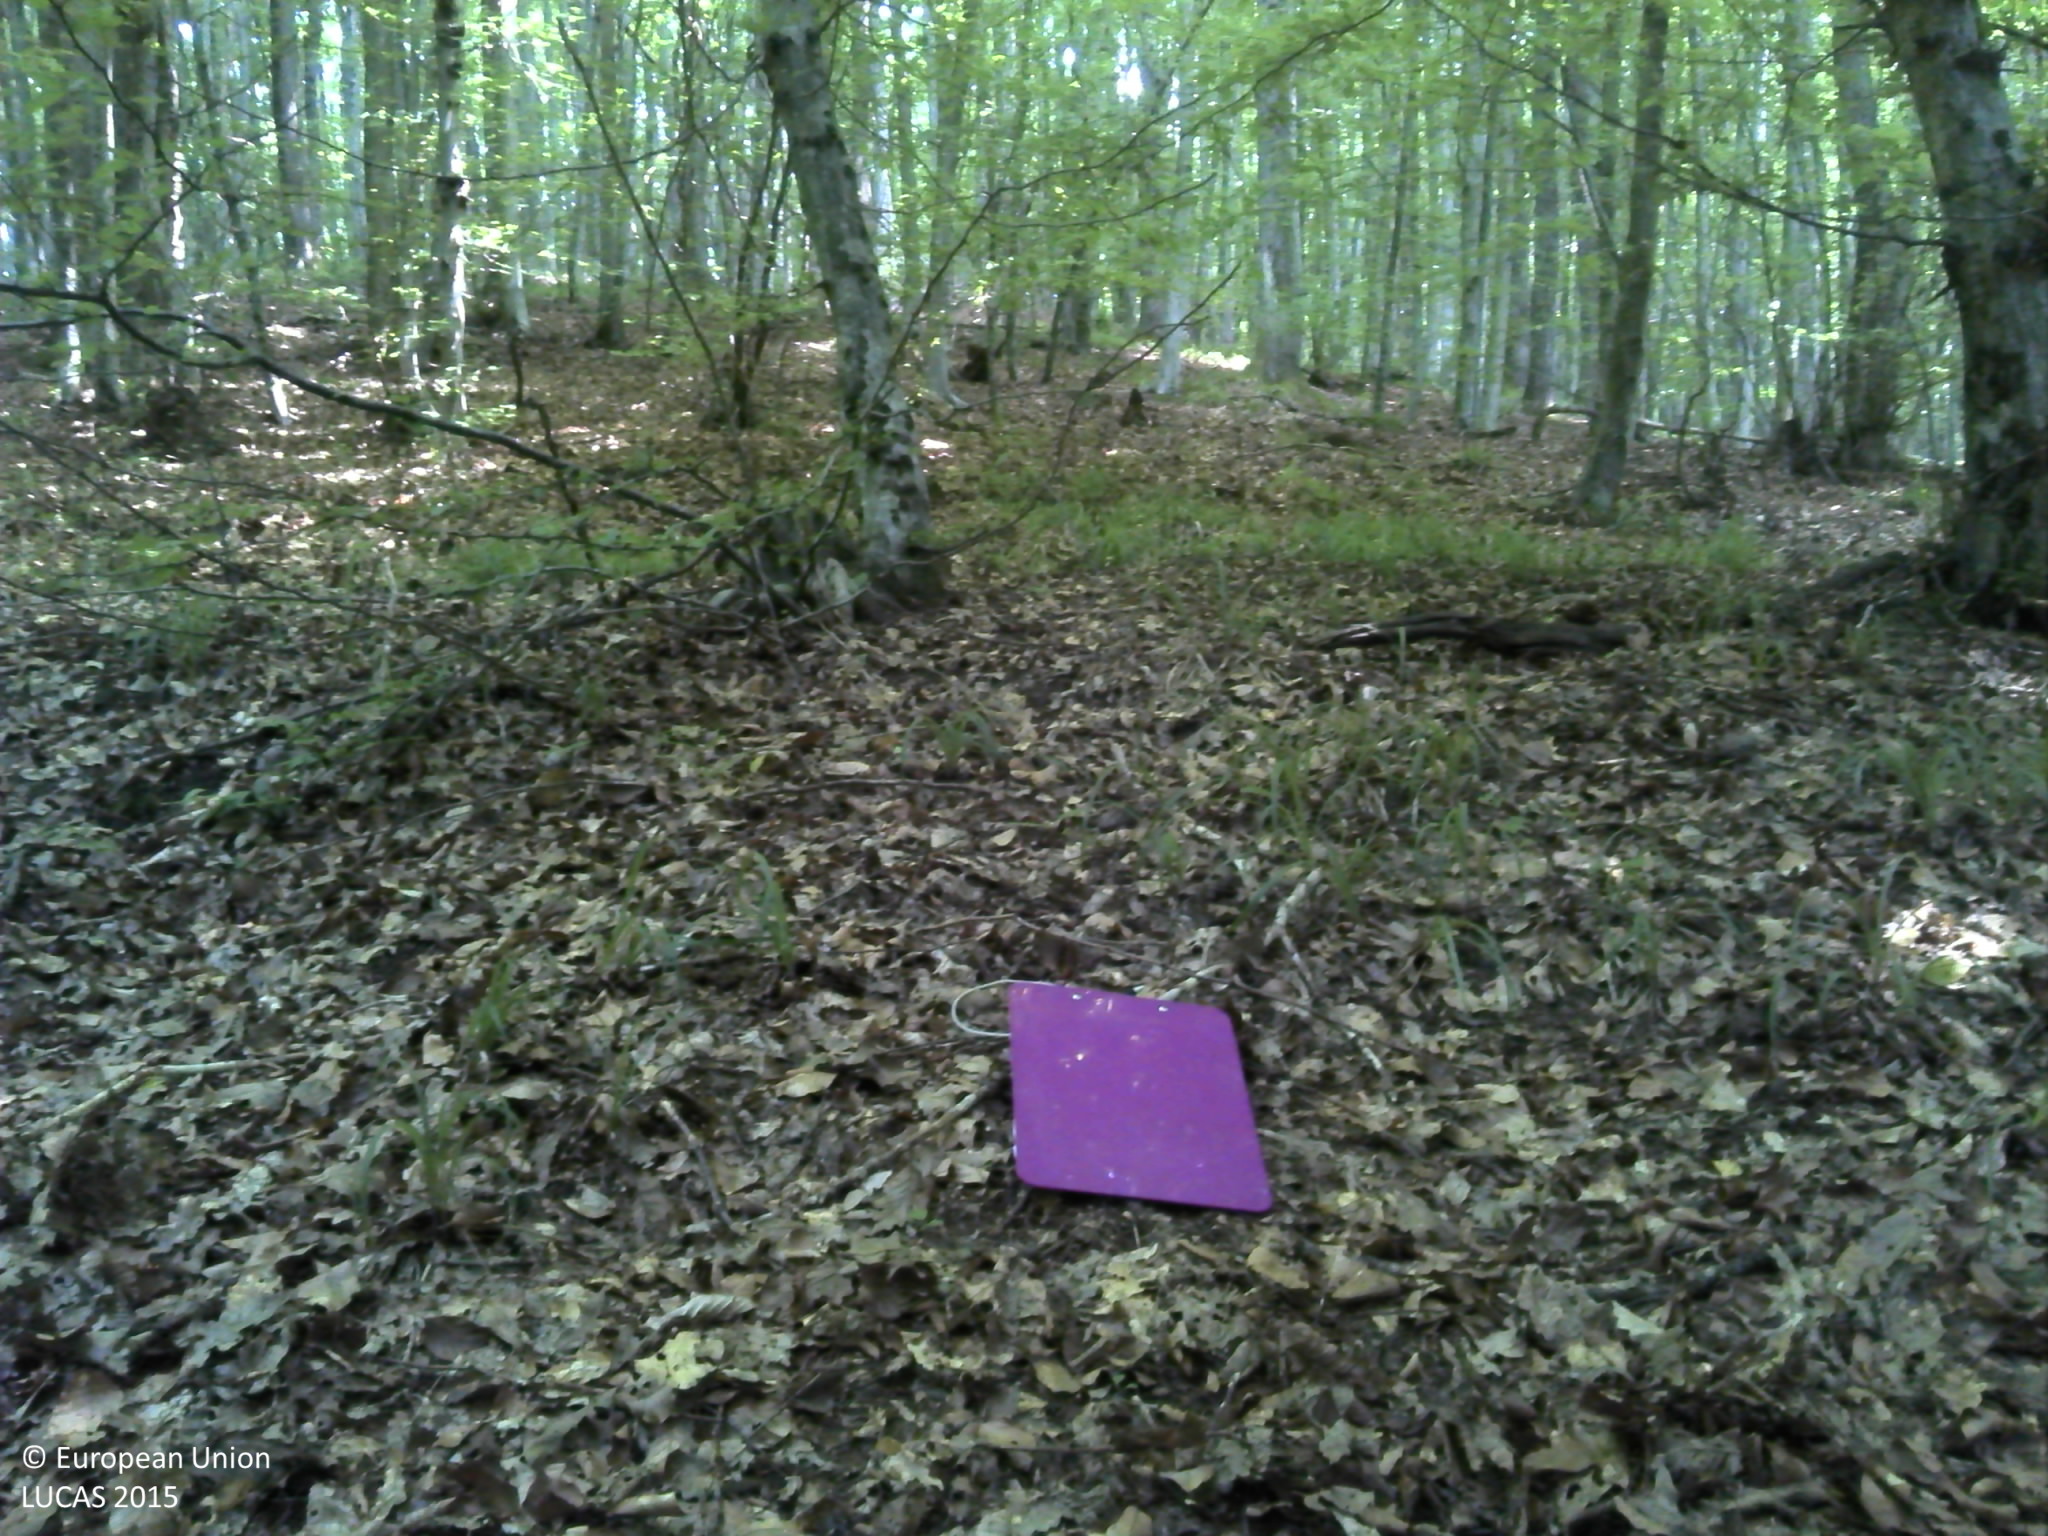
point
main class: Woodland
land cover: Broadleaved woodland
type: beech forest
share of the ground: > 75 %
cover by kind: broadleaved forest trees 80 %, lichens and mosses 20 %
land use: Forestry
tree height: > 5 m
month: June
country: HR
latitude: 45.4001
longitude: 17.2436
